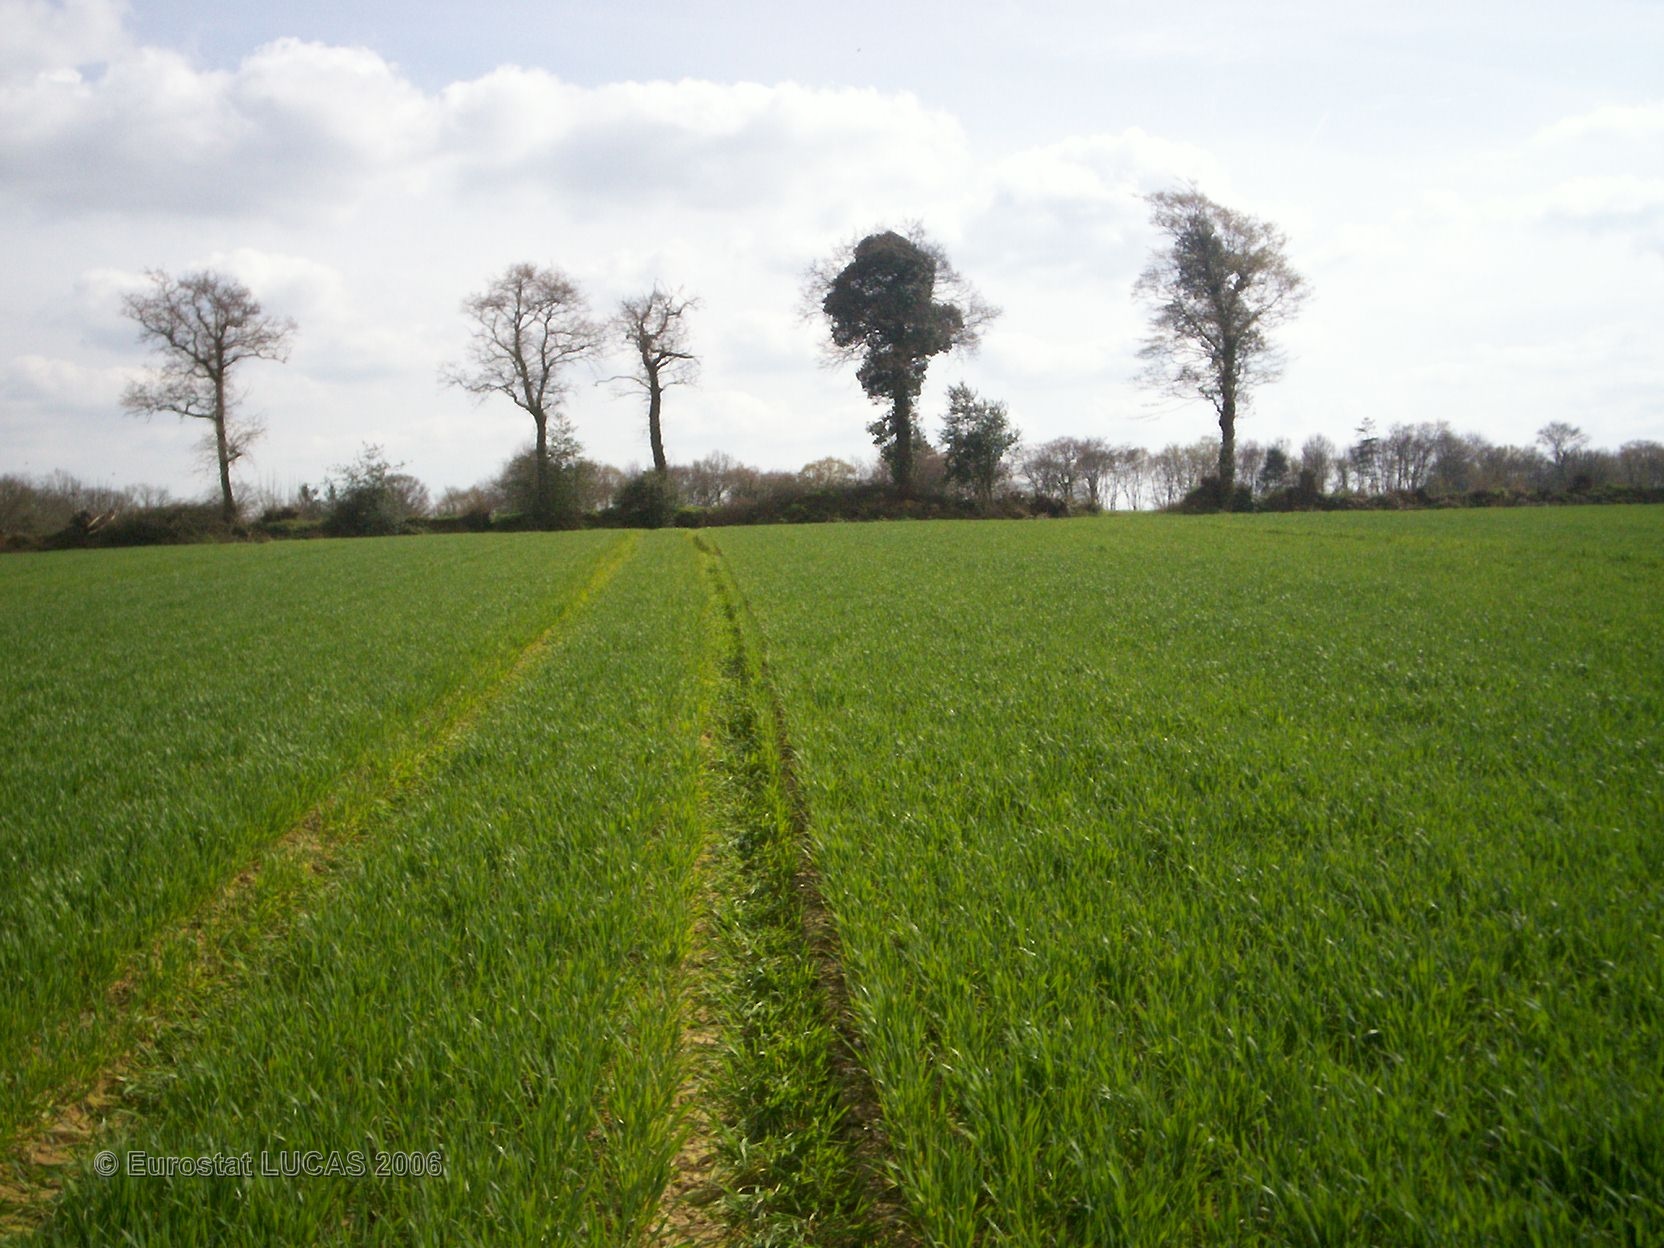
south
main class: Cropland
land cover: Common wheat
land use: Agriculture (excluding fallow land and kitchen gardens)
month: April
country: FR
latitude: 47.9568
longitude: -1.5760
